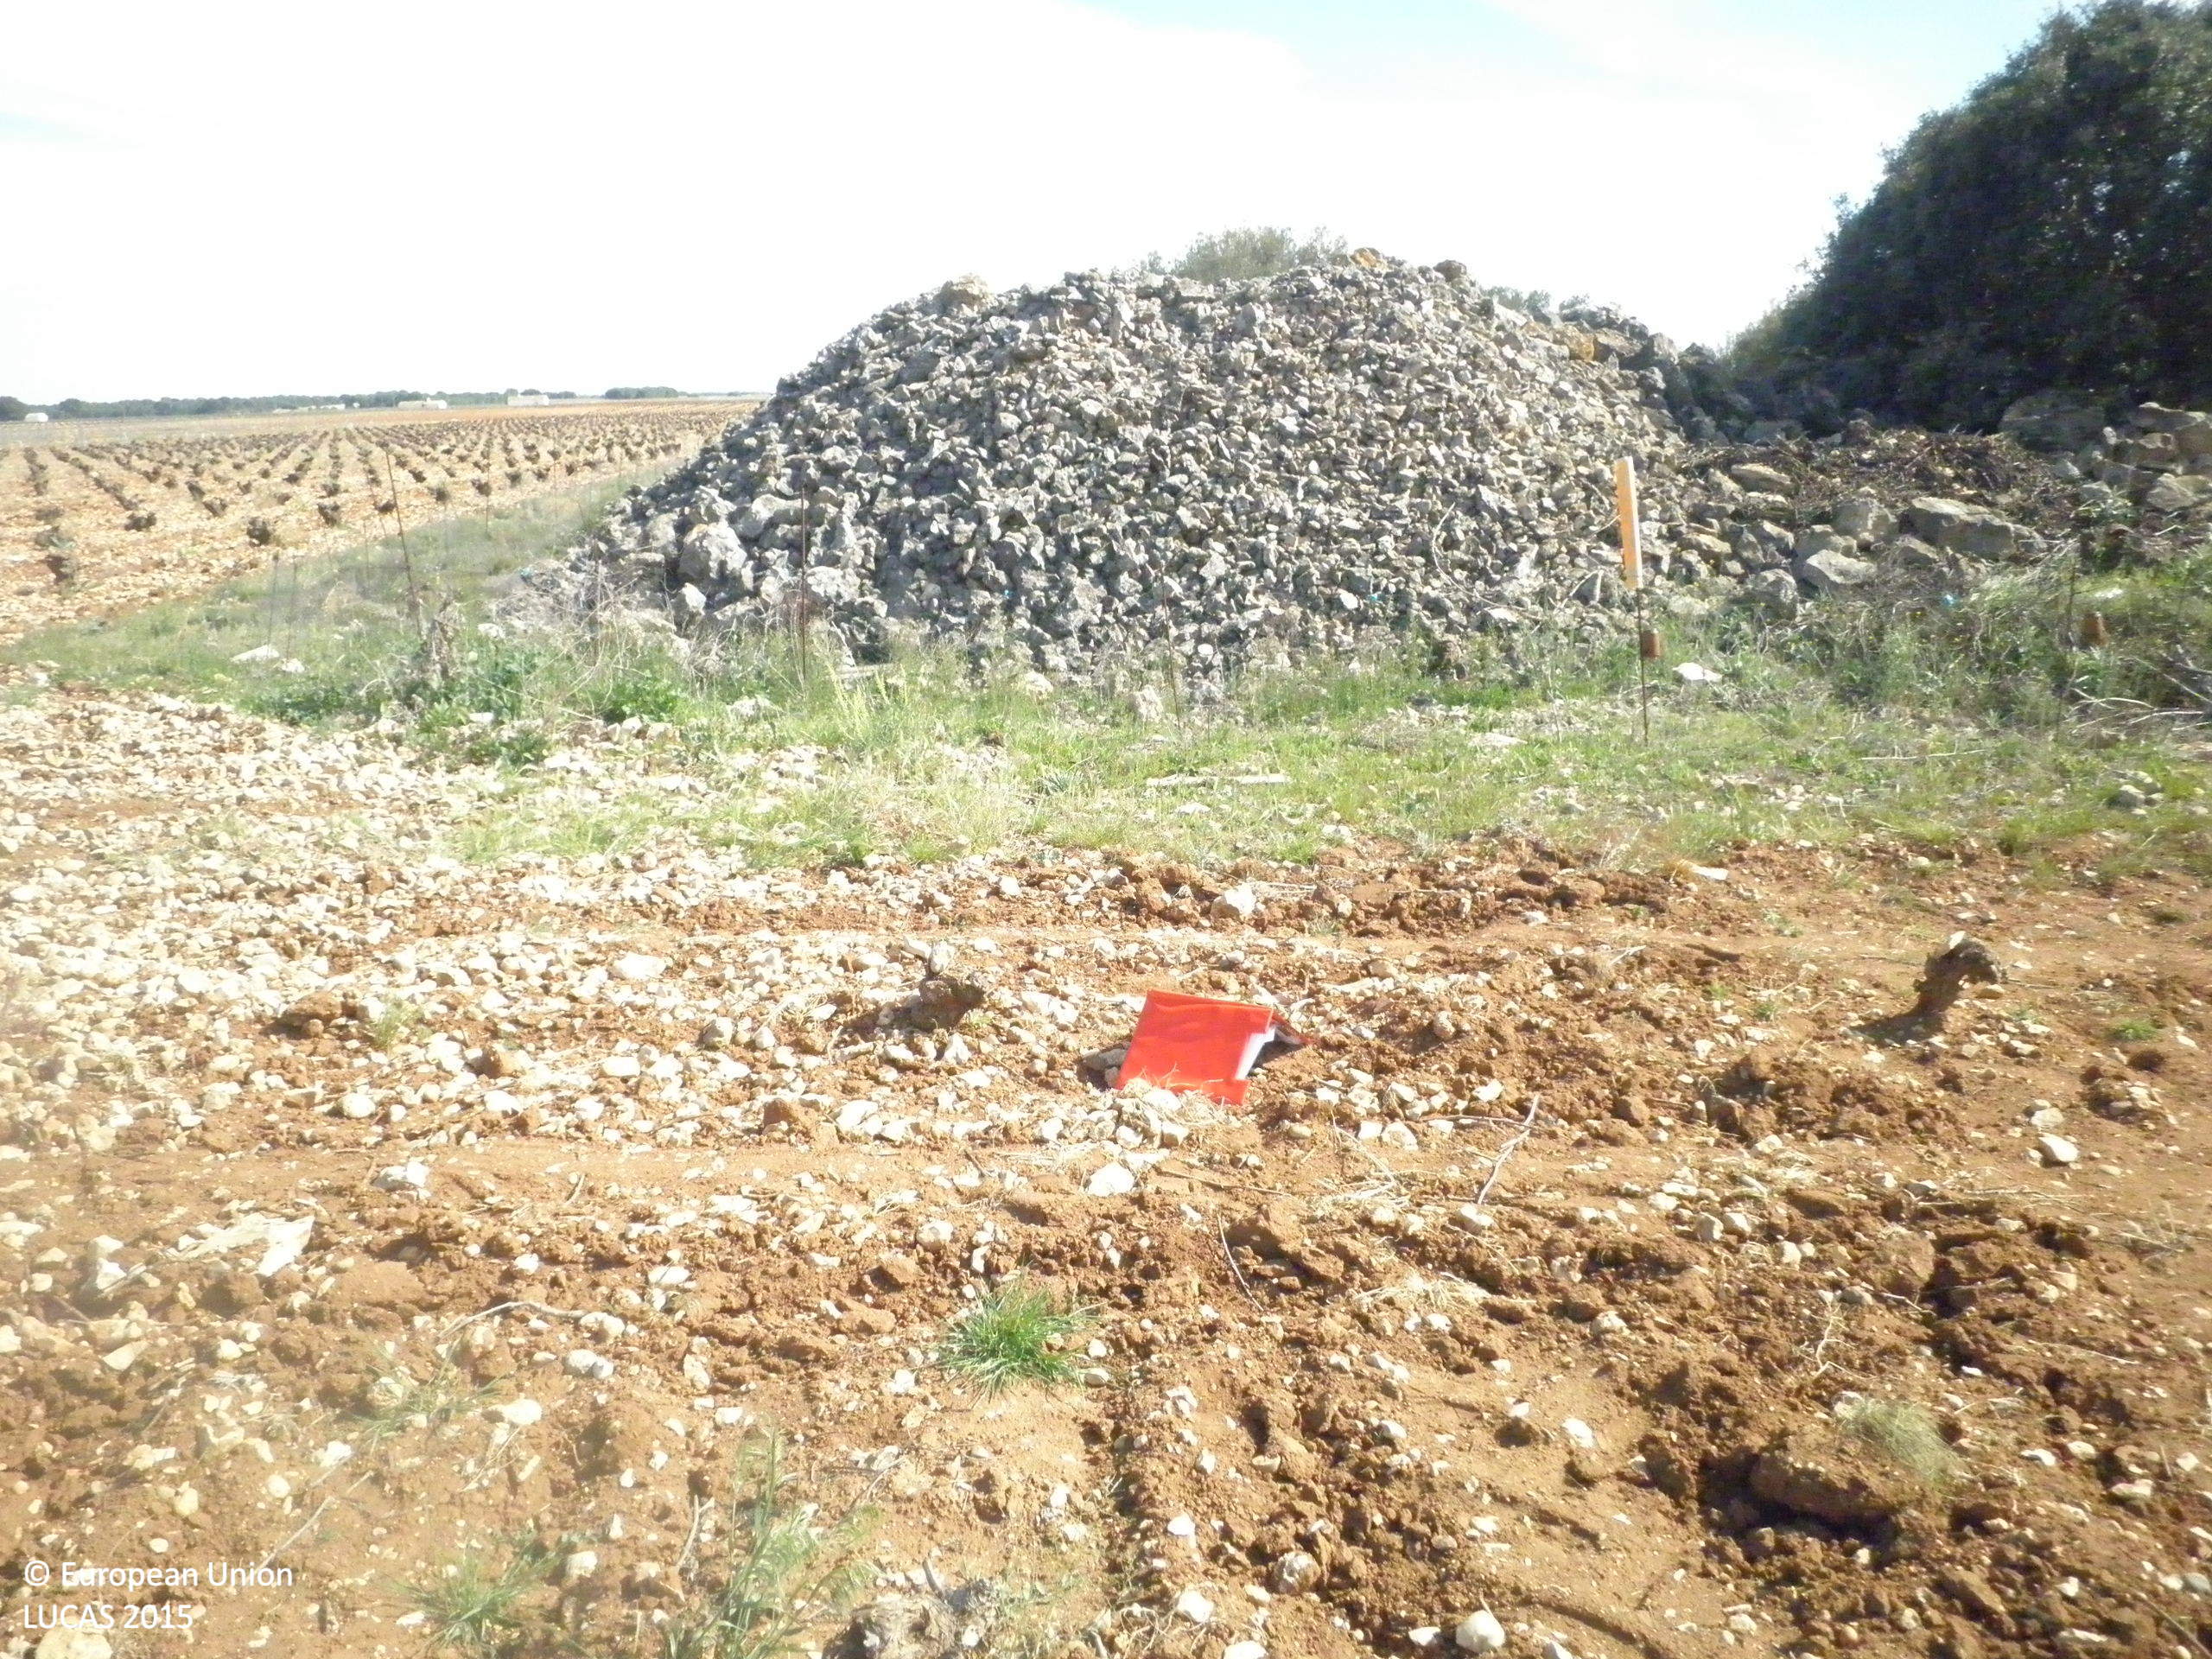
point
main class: Cropland
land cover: Vineyards
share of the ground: < 10 %
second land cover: Other bare soil
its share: > 75 %
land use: Agriculture (excluding fallow land and kitchen gardens)
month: April
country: ES
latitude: 39.3506
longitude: -2.6719
